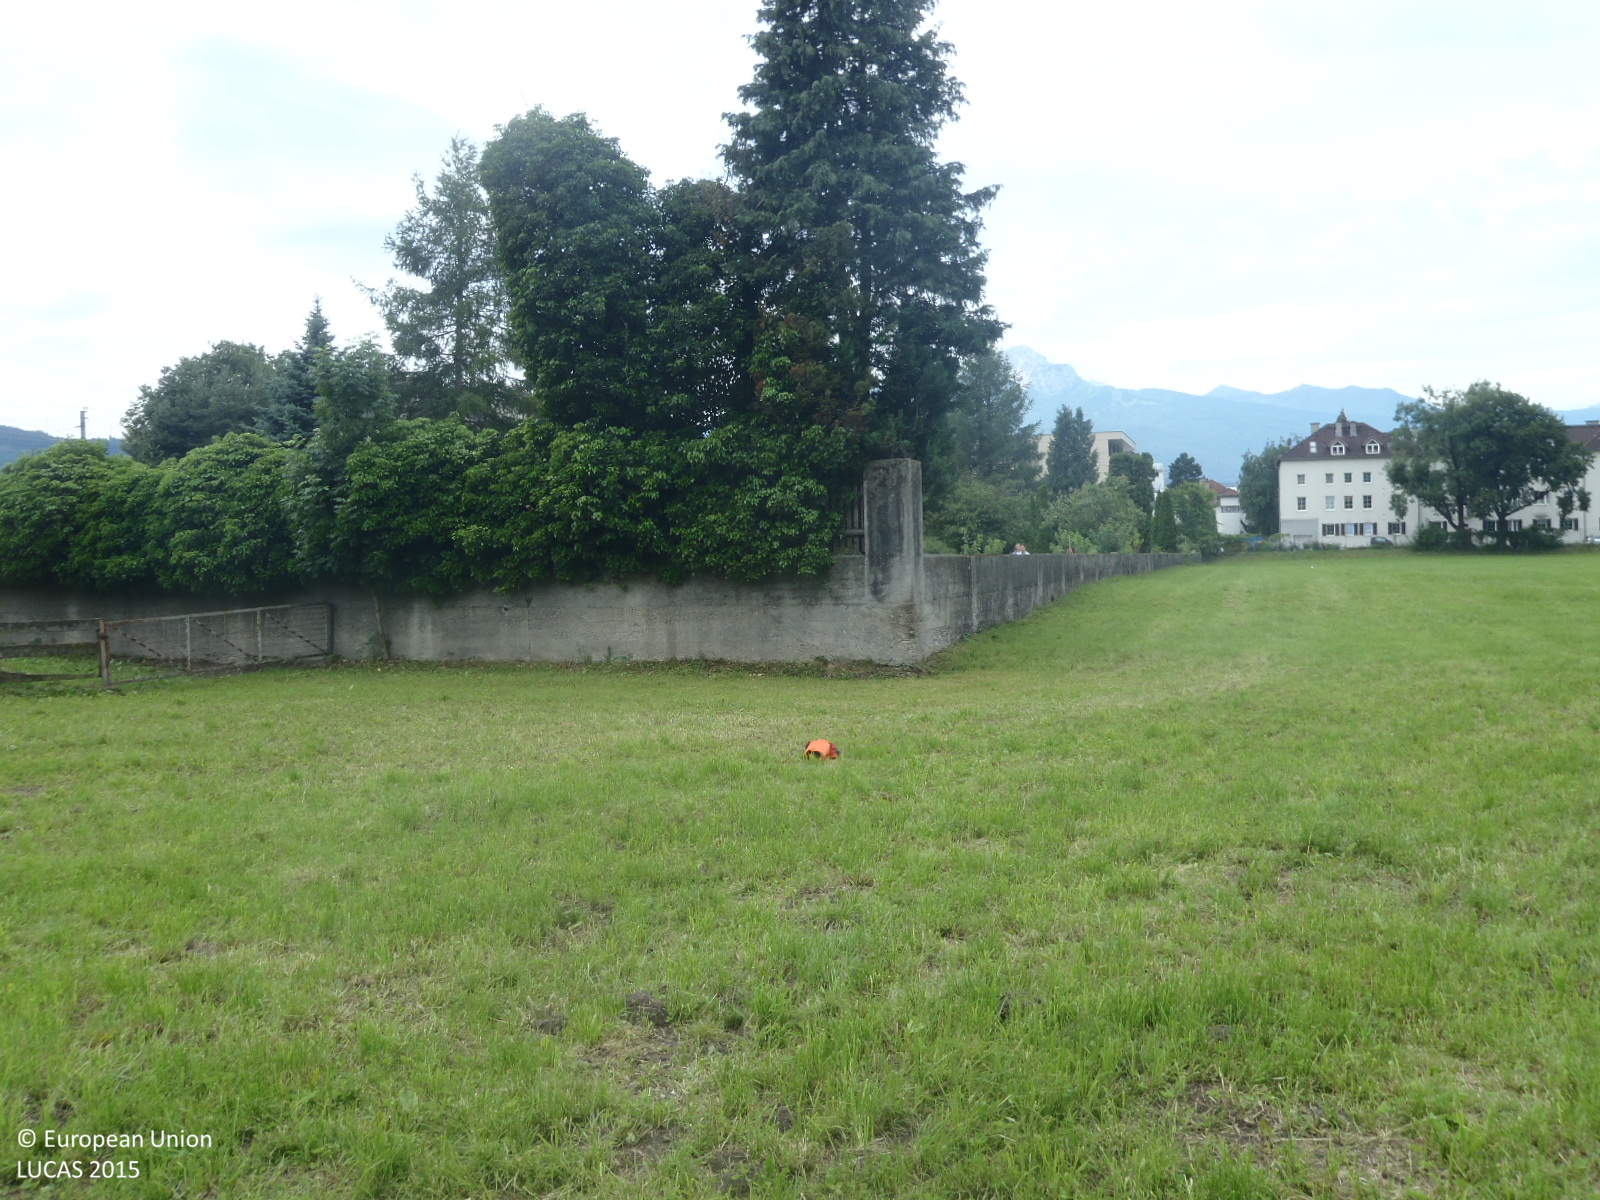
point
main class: Grassland
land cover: Grassland without tree/shrub cover
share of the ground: > 75 %
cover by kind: herbaceous plants 100 %
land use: Agriculture (excluding fallow land and kitchen gardens)
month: June
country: AT
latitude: 47.2784
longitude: 11.4132
